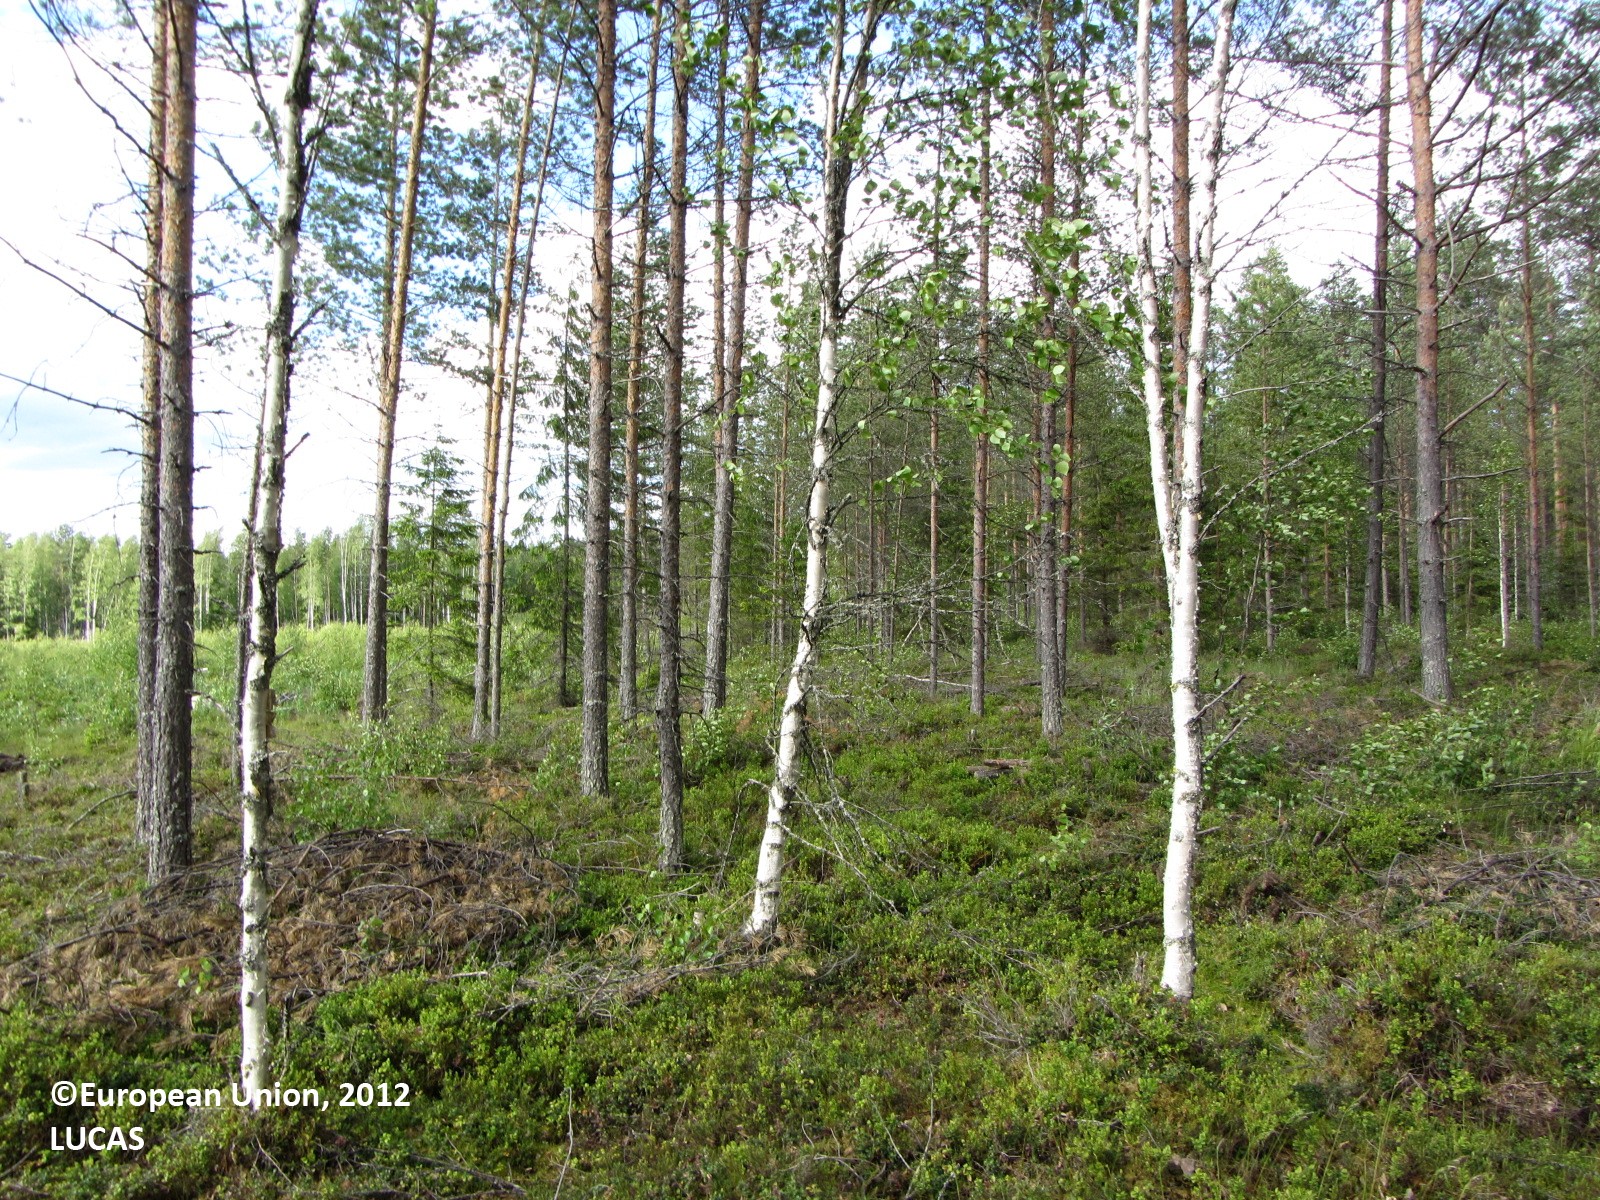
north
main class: Woodland
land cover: Pine dominated coniferous woodland
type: boreal forest
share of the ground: 50 - 75 %
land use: Forestry
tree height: > 5 m
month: June
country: FI
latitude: 62.3410
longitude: 25.1080
